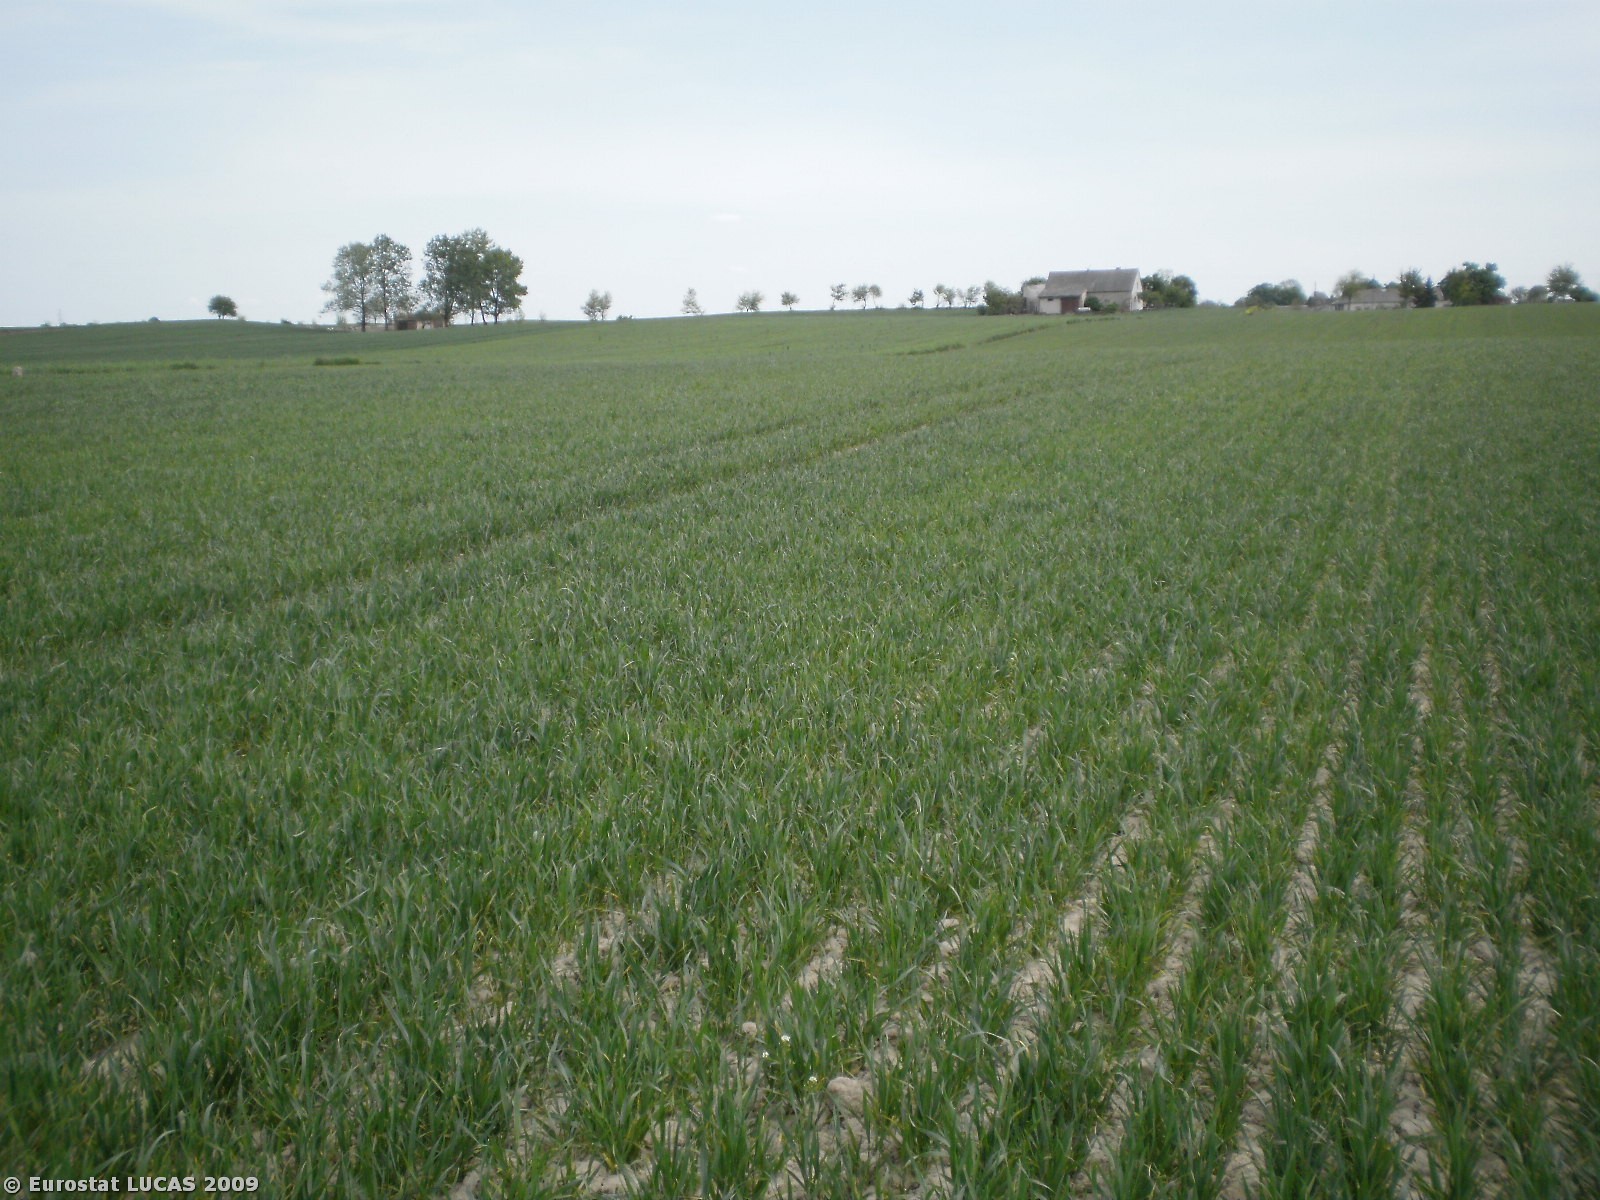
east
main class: Cropland
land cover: Common wheat
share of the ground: 50 - 75 %
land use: Agriculture (excluding fallow land and kitchen gardens)
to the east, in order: Common wheat; Grass margins; Barley
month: May
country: PL
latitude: 53.2983
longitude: 18.7983
